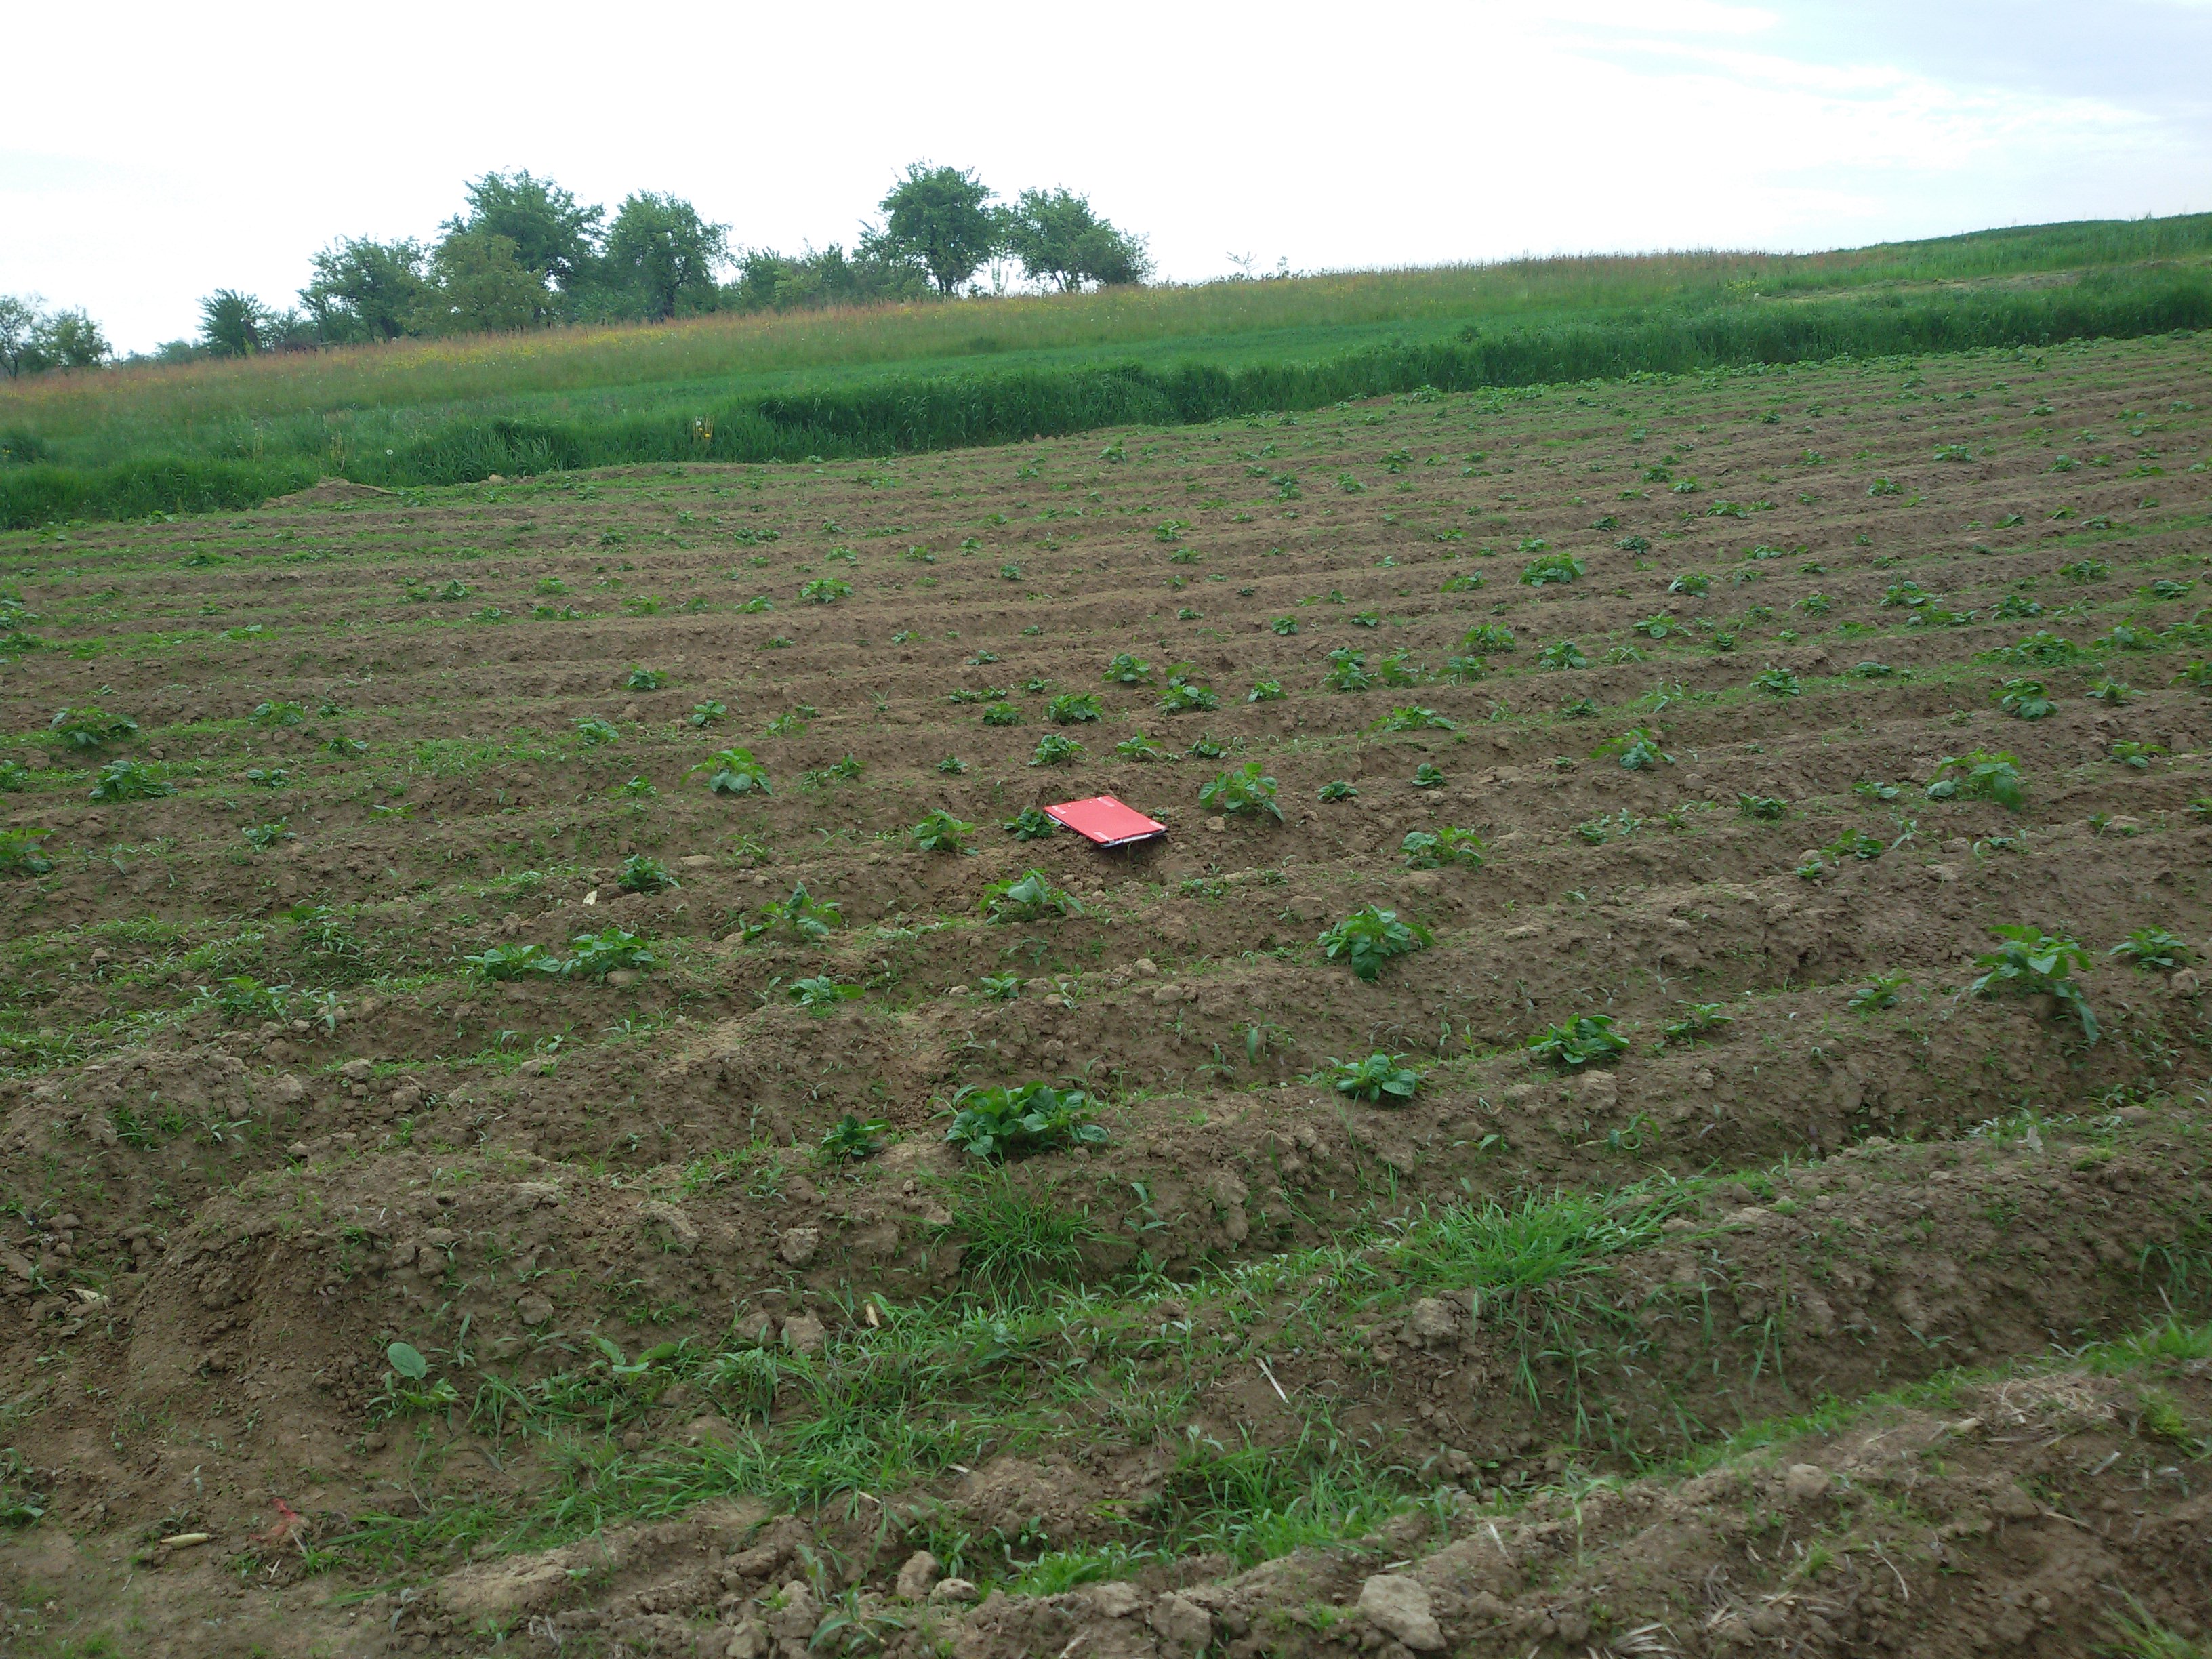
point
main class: Cropland
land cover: Potatoes
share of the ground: < 10 %
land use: Agriculture (excluding fallow land and kitchen gardens)
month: May
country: PL
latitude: 50.1104
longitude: 21.3042
